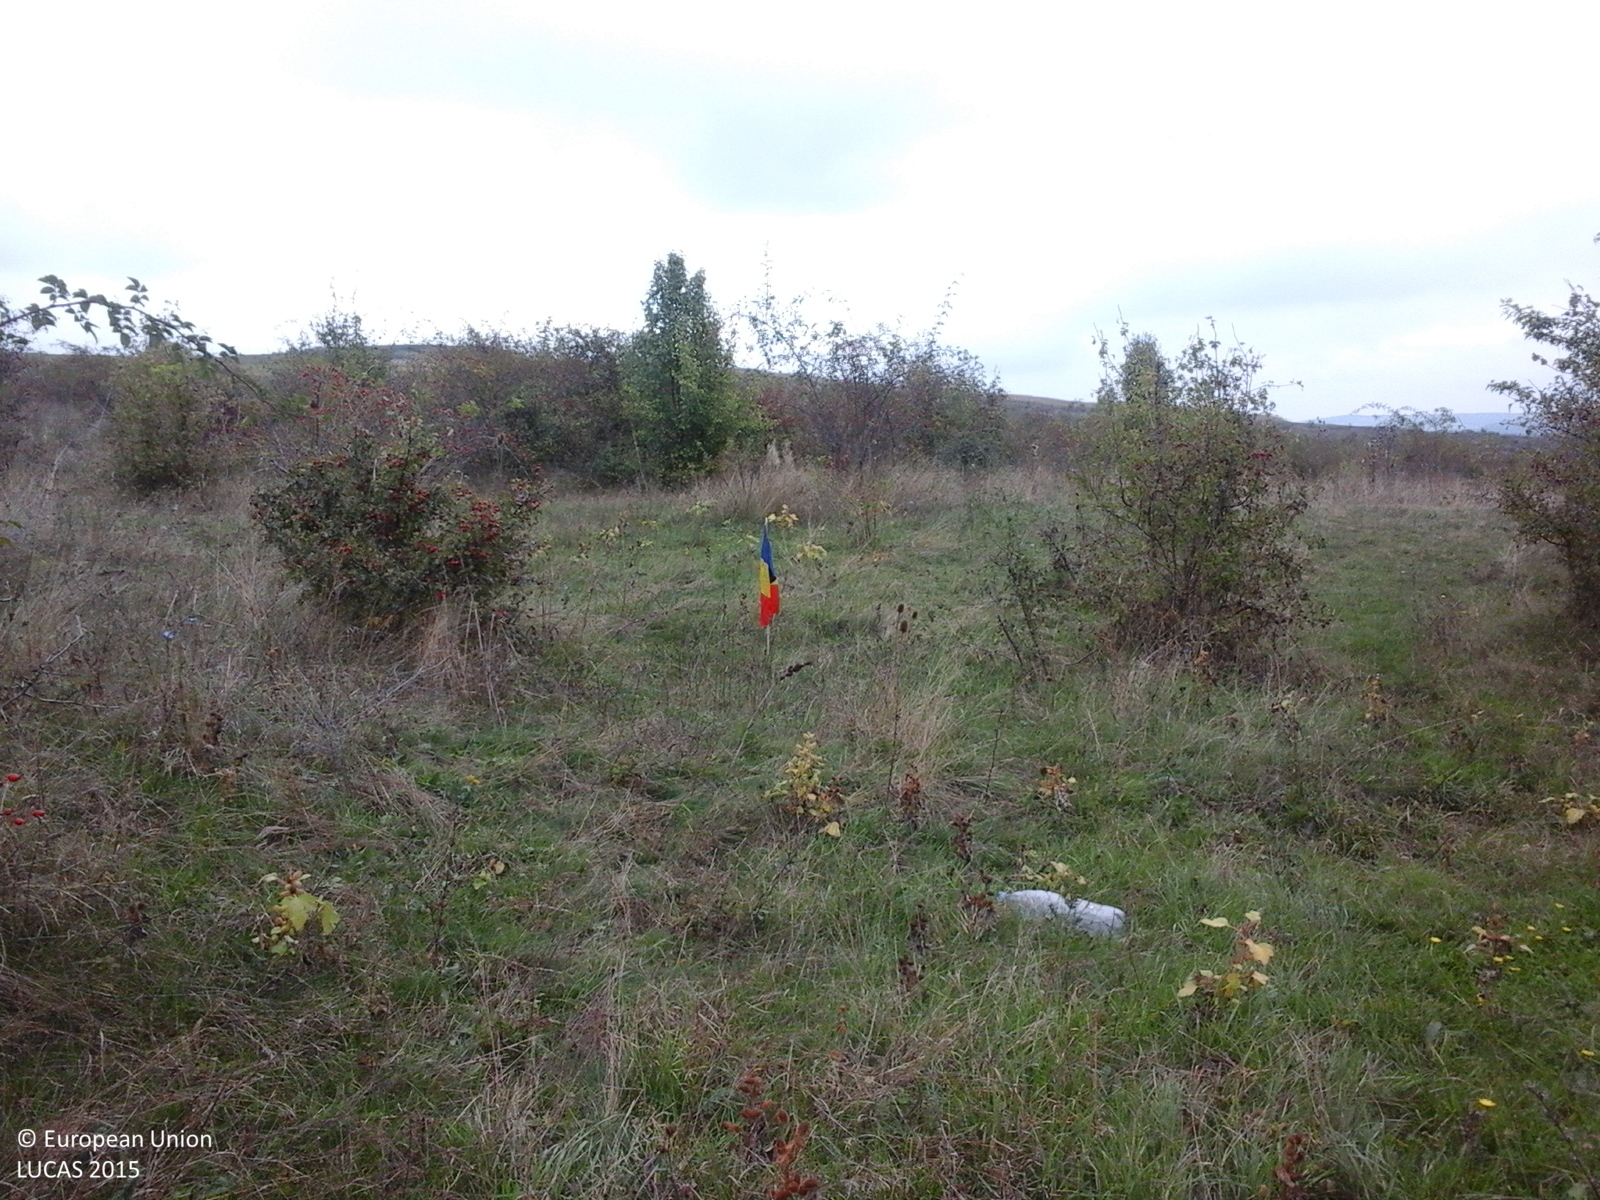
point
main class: Grassland
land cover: Grassland with sparse tree/shrub cover
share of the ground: > 75 %
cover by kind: herbaceous plants 95 %, broadleaved forest trees 5 %
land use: Semi-natural and natural areas not in use
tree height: < 5 m
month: October
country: RO
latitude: 46.3716
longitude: 24.0252
